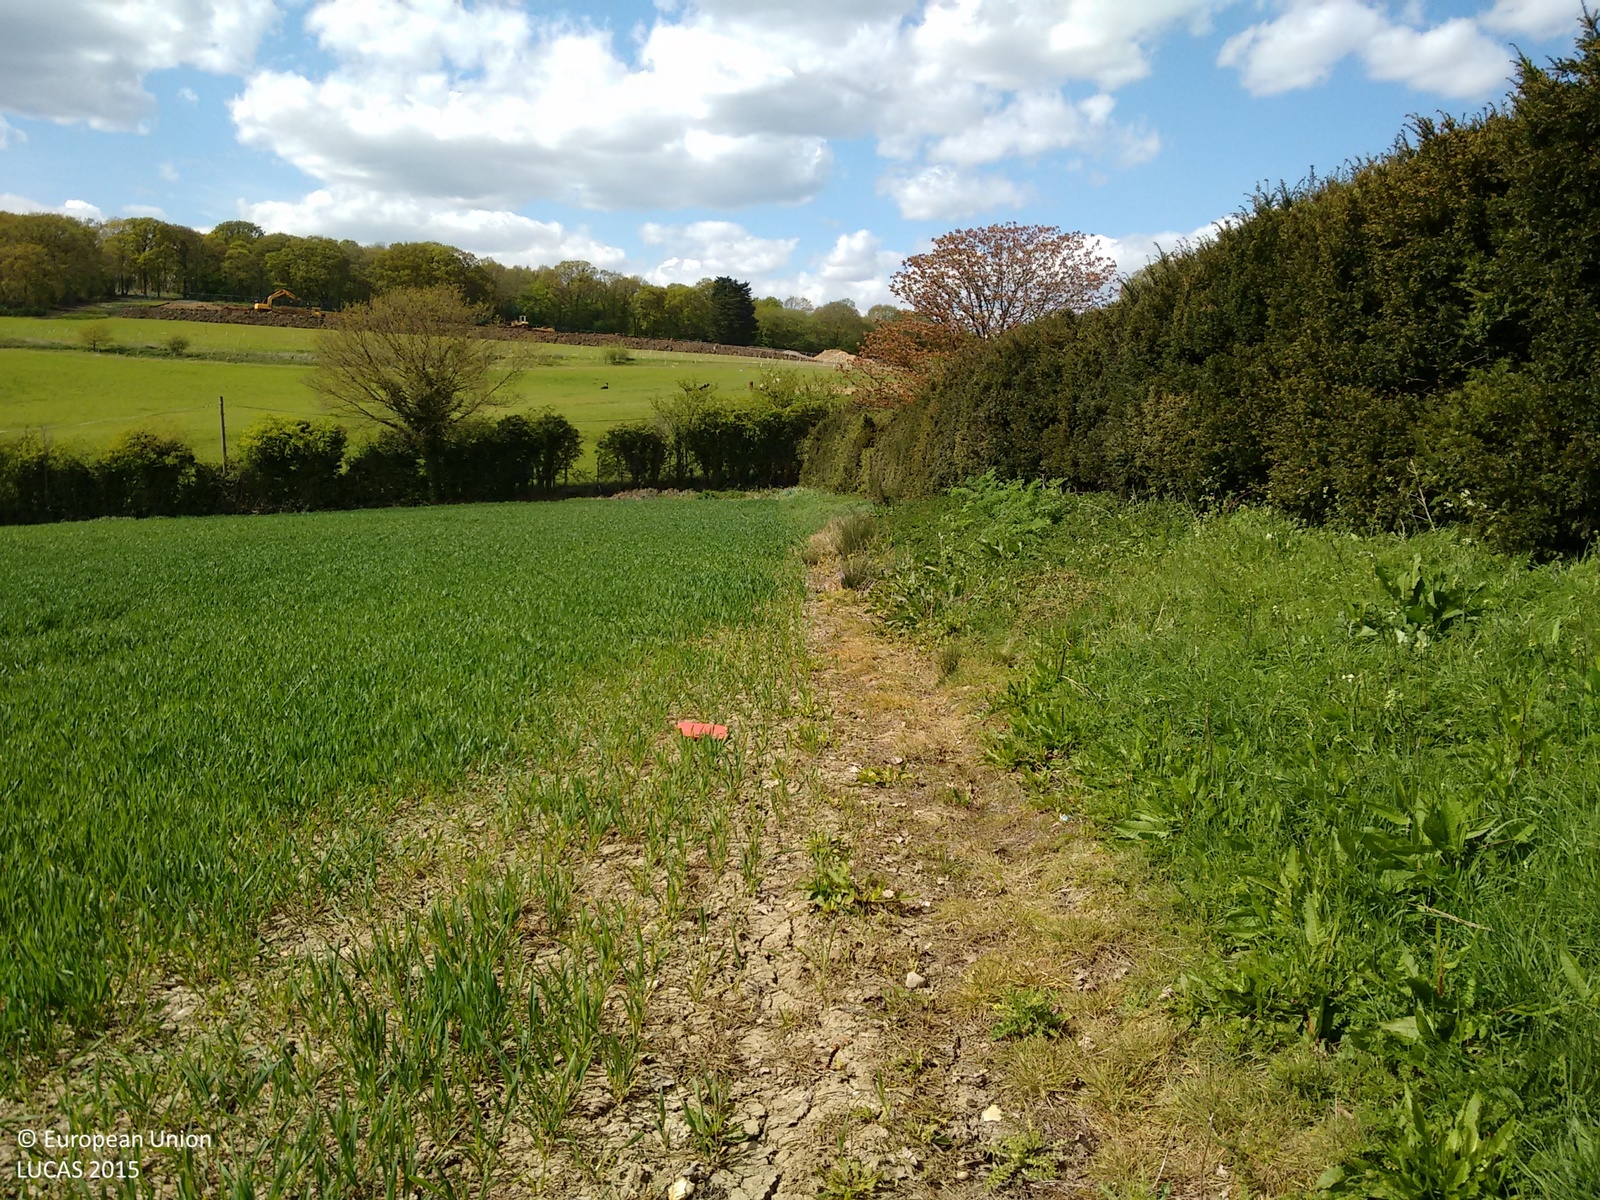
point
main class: Cropland
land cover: Common wheat
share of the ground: > 75 %
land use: Agriculture (excluding fallow land and kitchen gardens)
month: April
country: GB
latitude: 51.3587
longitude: 0.6822
